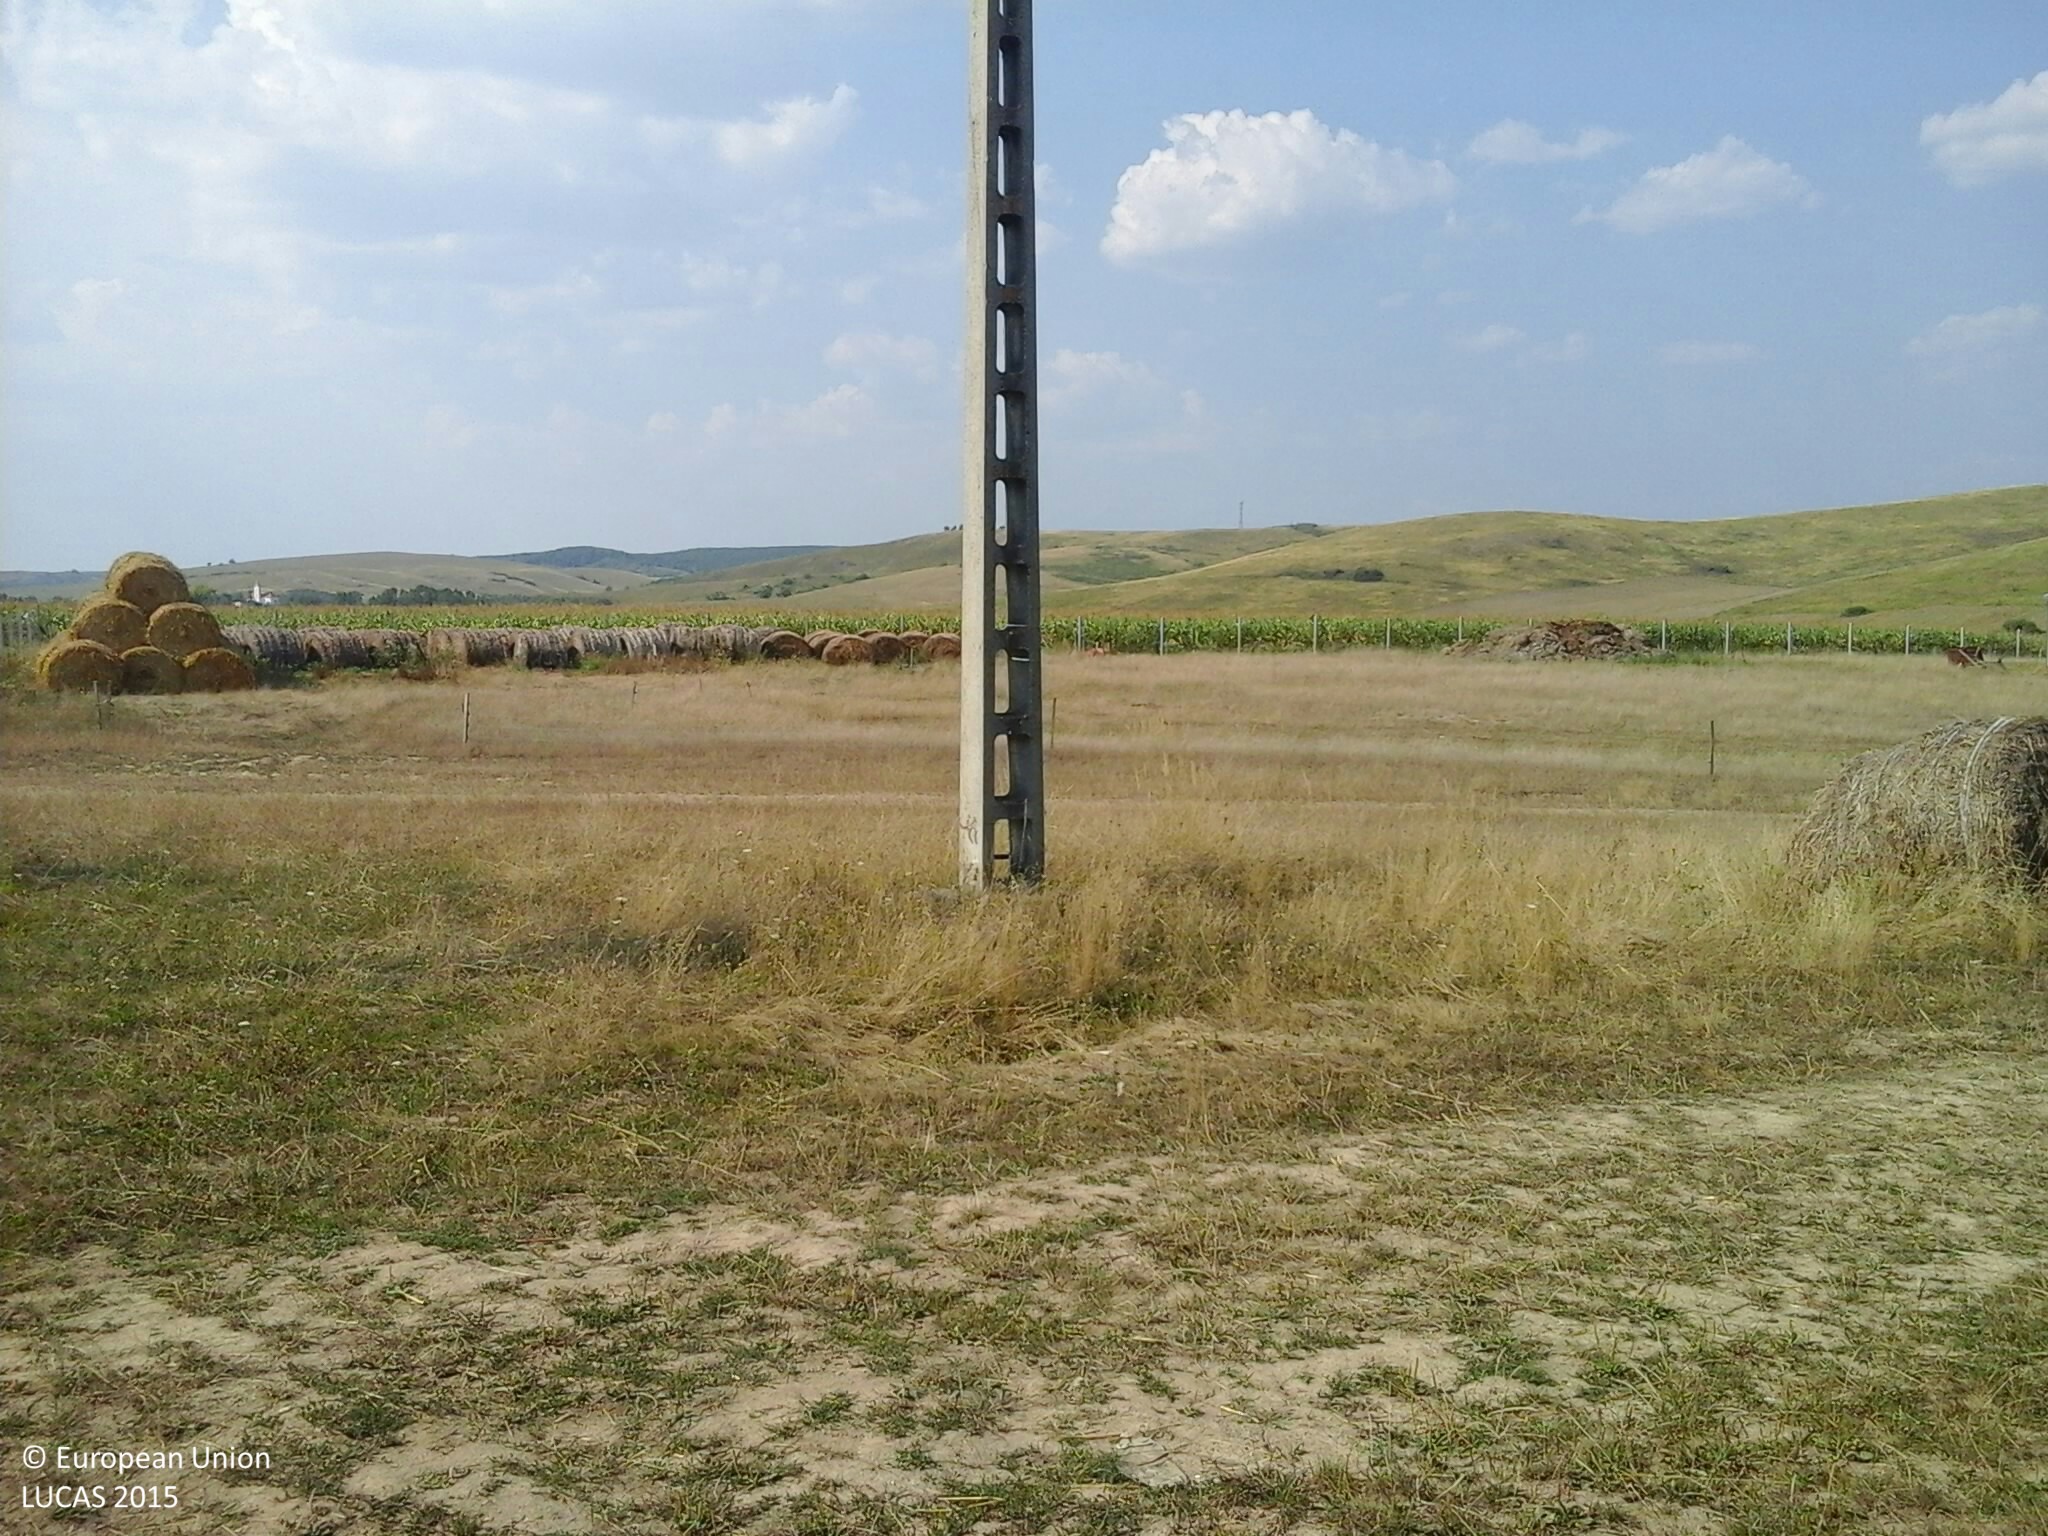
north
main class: Grassland
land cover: Grassland with sparse tree/shrub cover
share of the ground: > 75 %
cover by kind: herbaceous plants 95 %, broadleaved forest trees 5 %
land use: Agriculture (excluding fallow land and kitchen gardens)
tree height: < 5 m
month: August
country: HU
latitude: 48.3741
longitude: 20.4972
